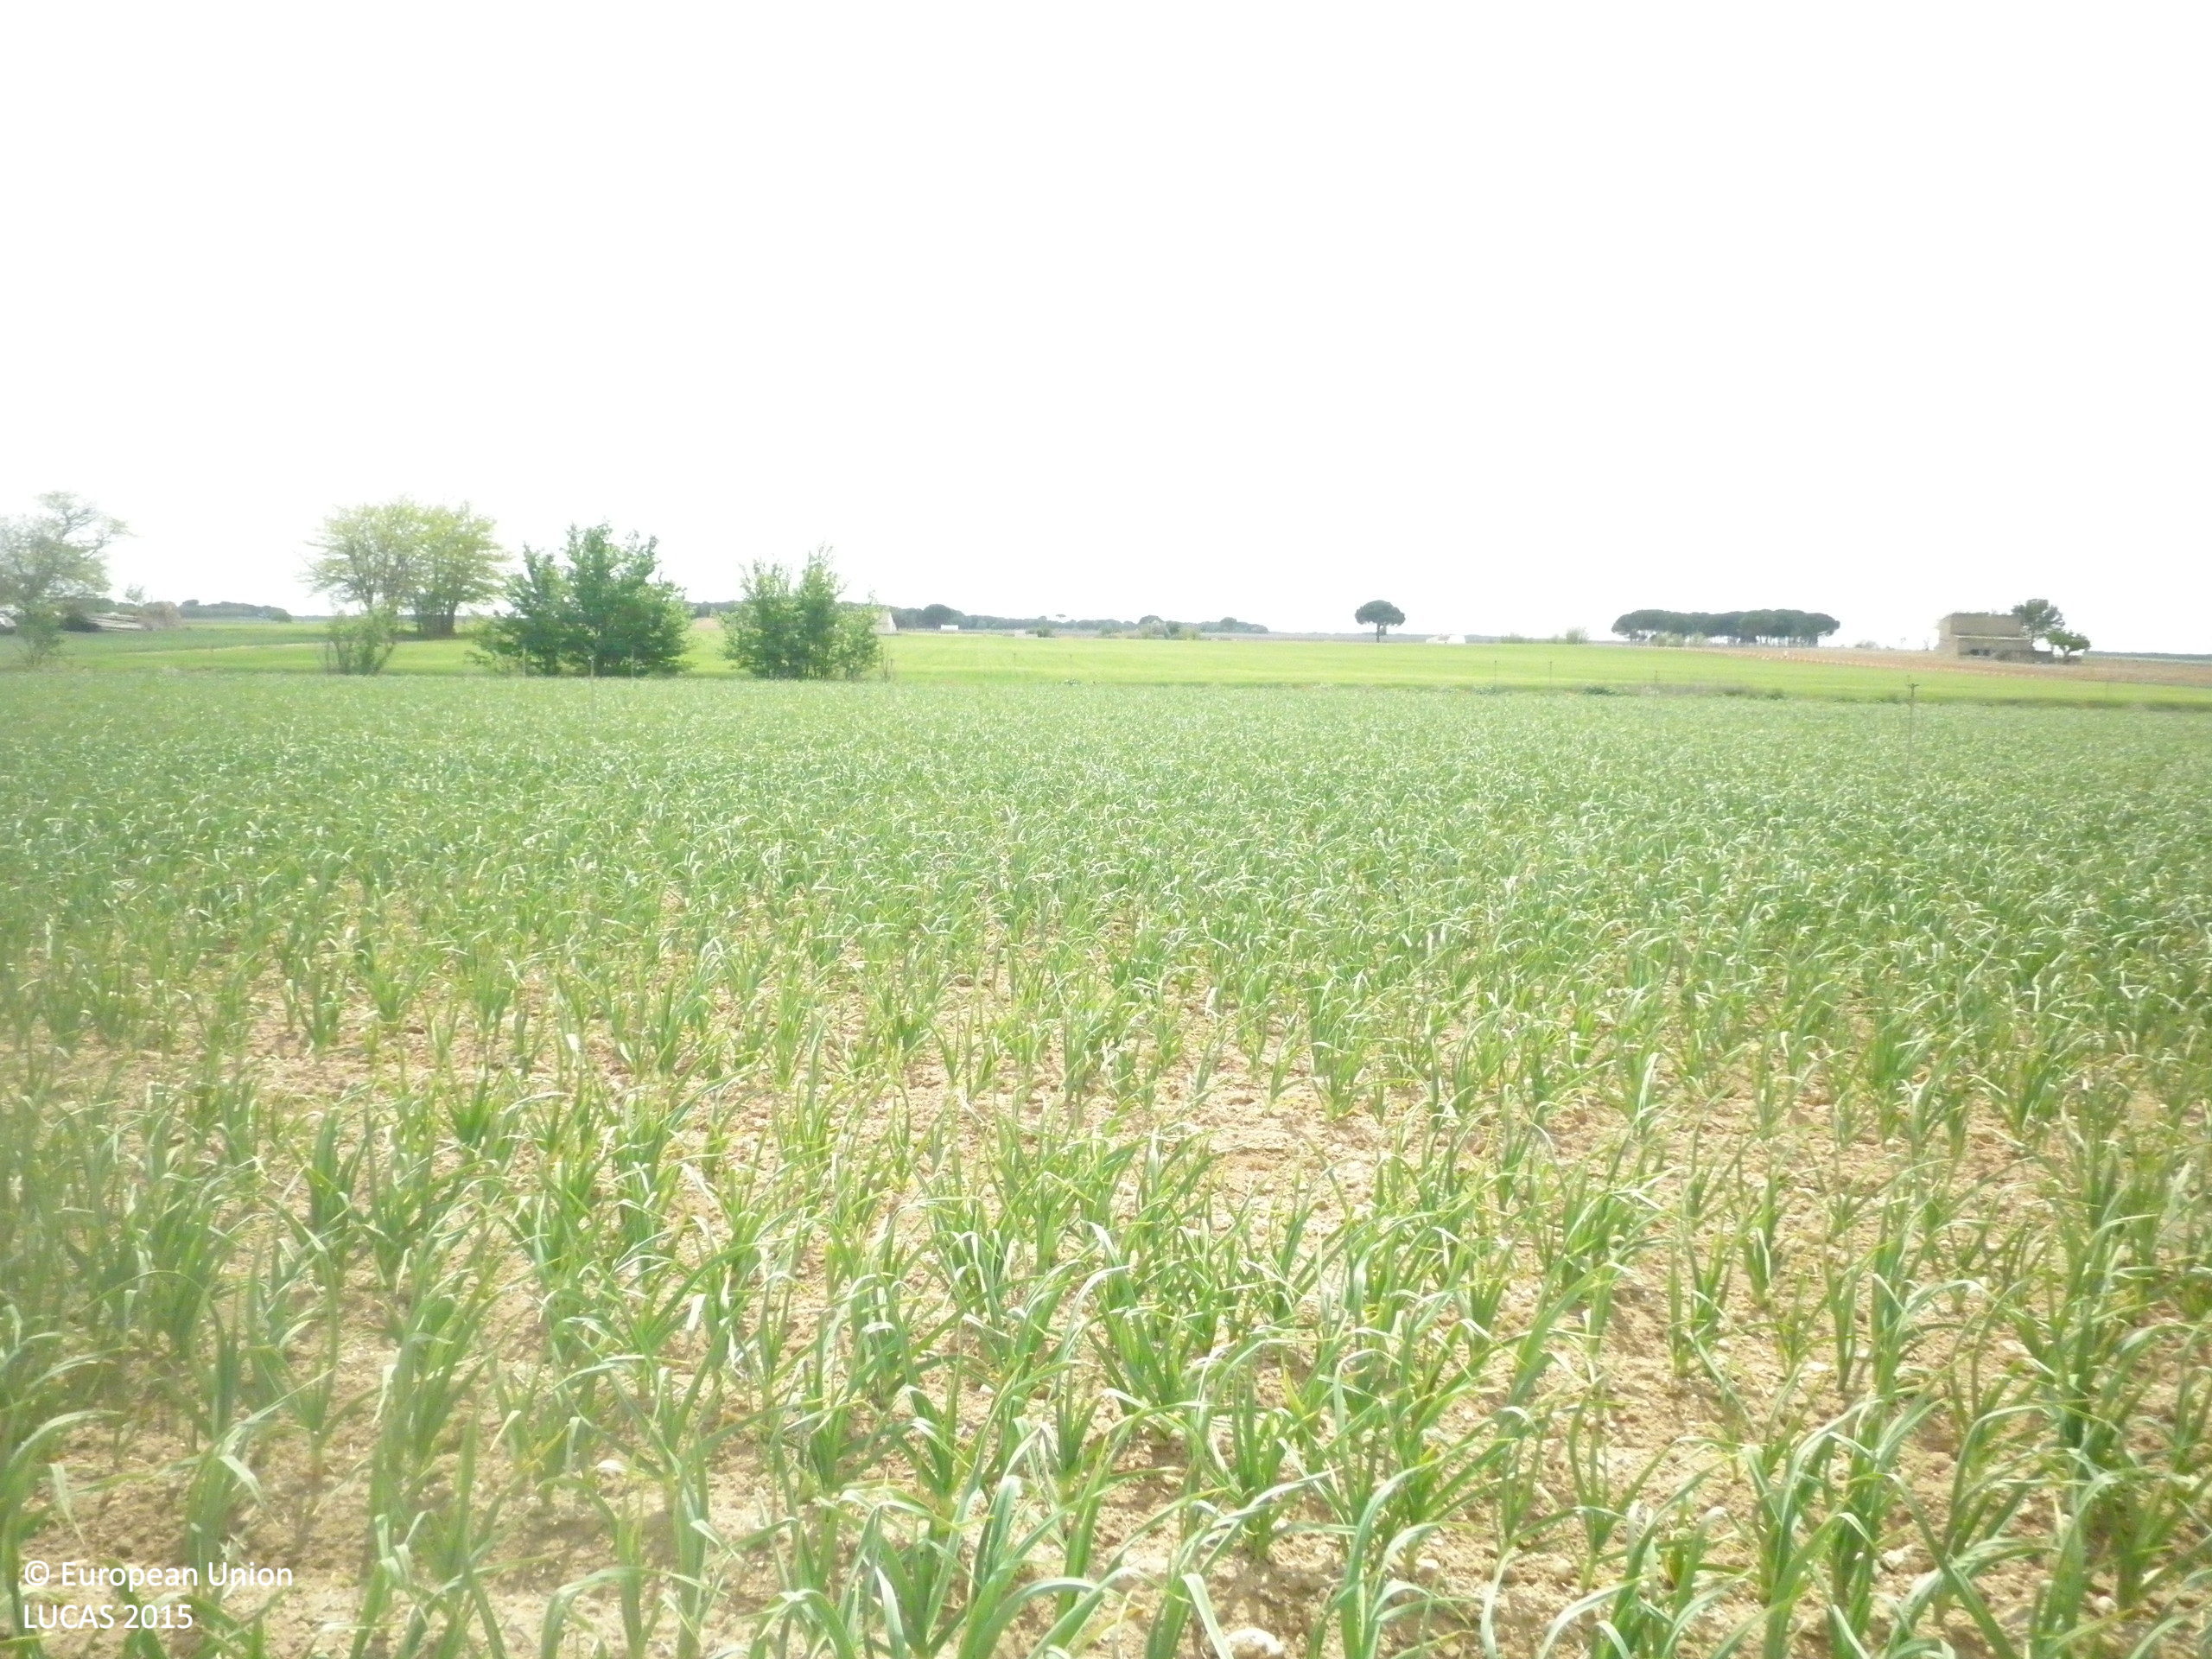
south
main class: Cropland
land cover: Other root crops
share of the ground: 10 - 25 %
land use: Agriculture (excluding fallow land and kitchen gardens)
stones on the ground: < 10 %
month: April
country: ES
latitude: 39.4219
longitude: -2.6859
